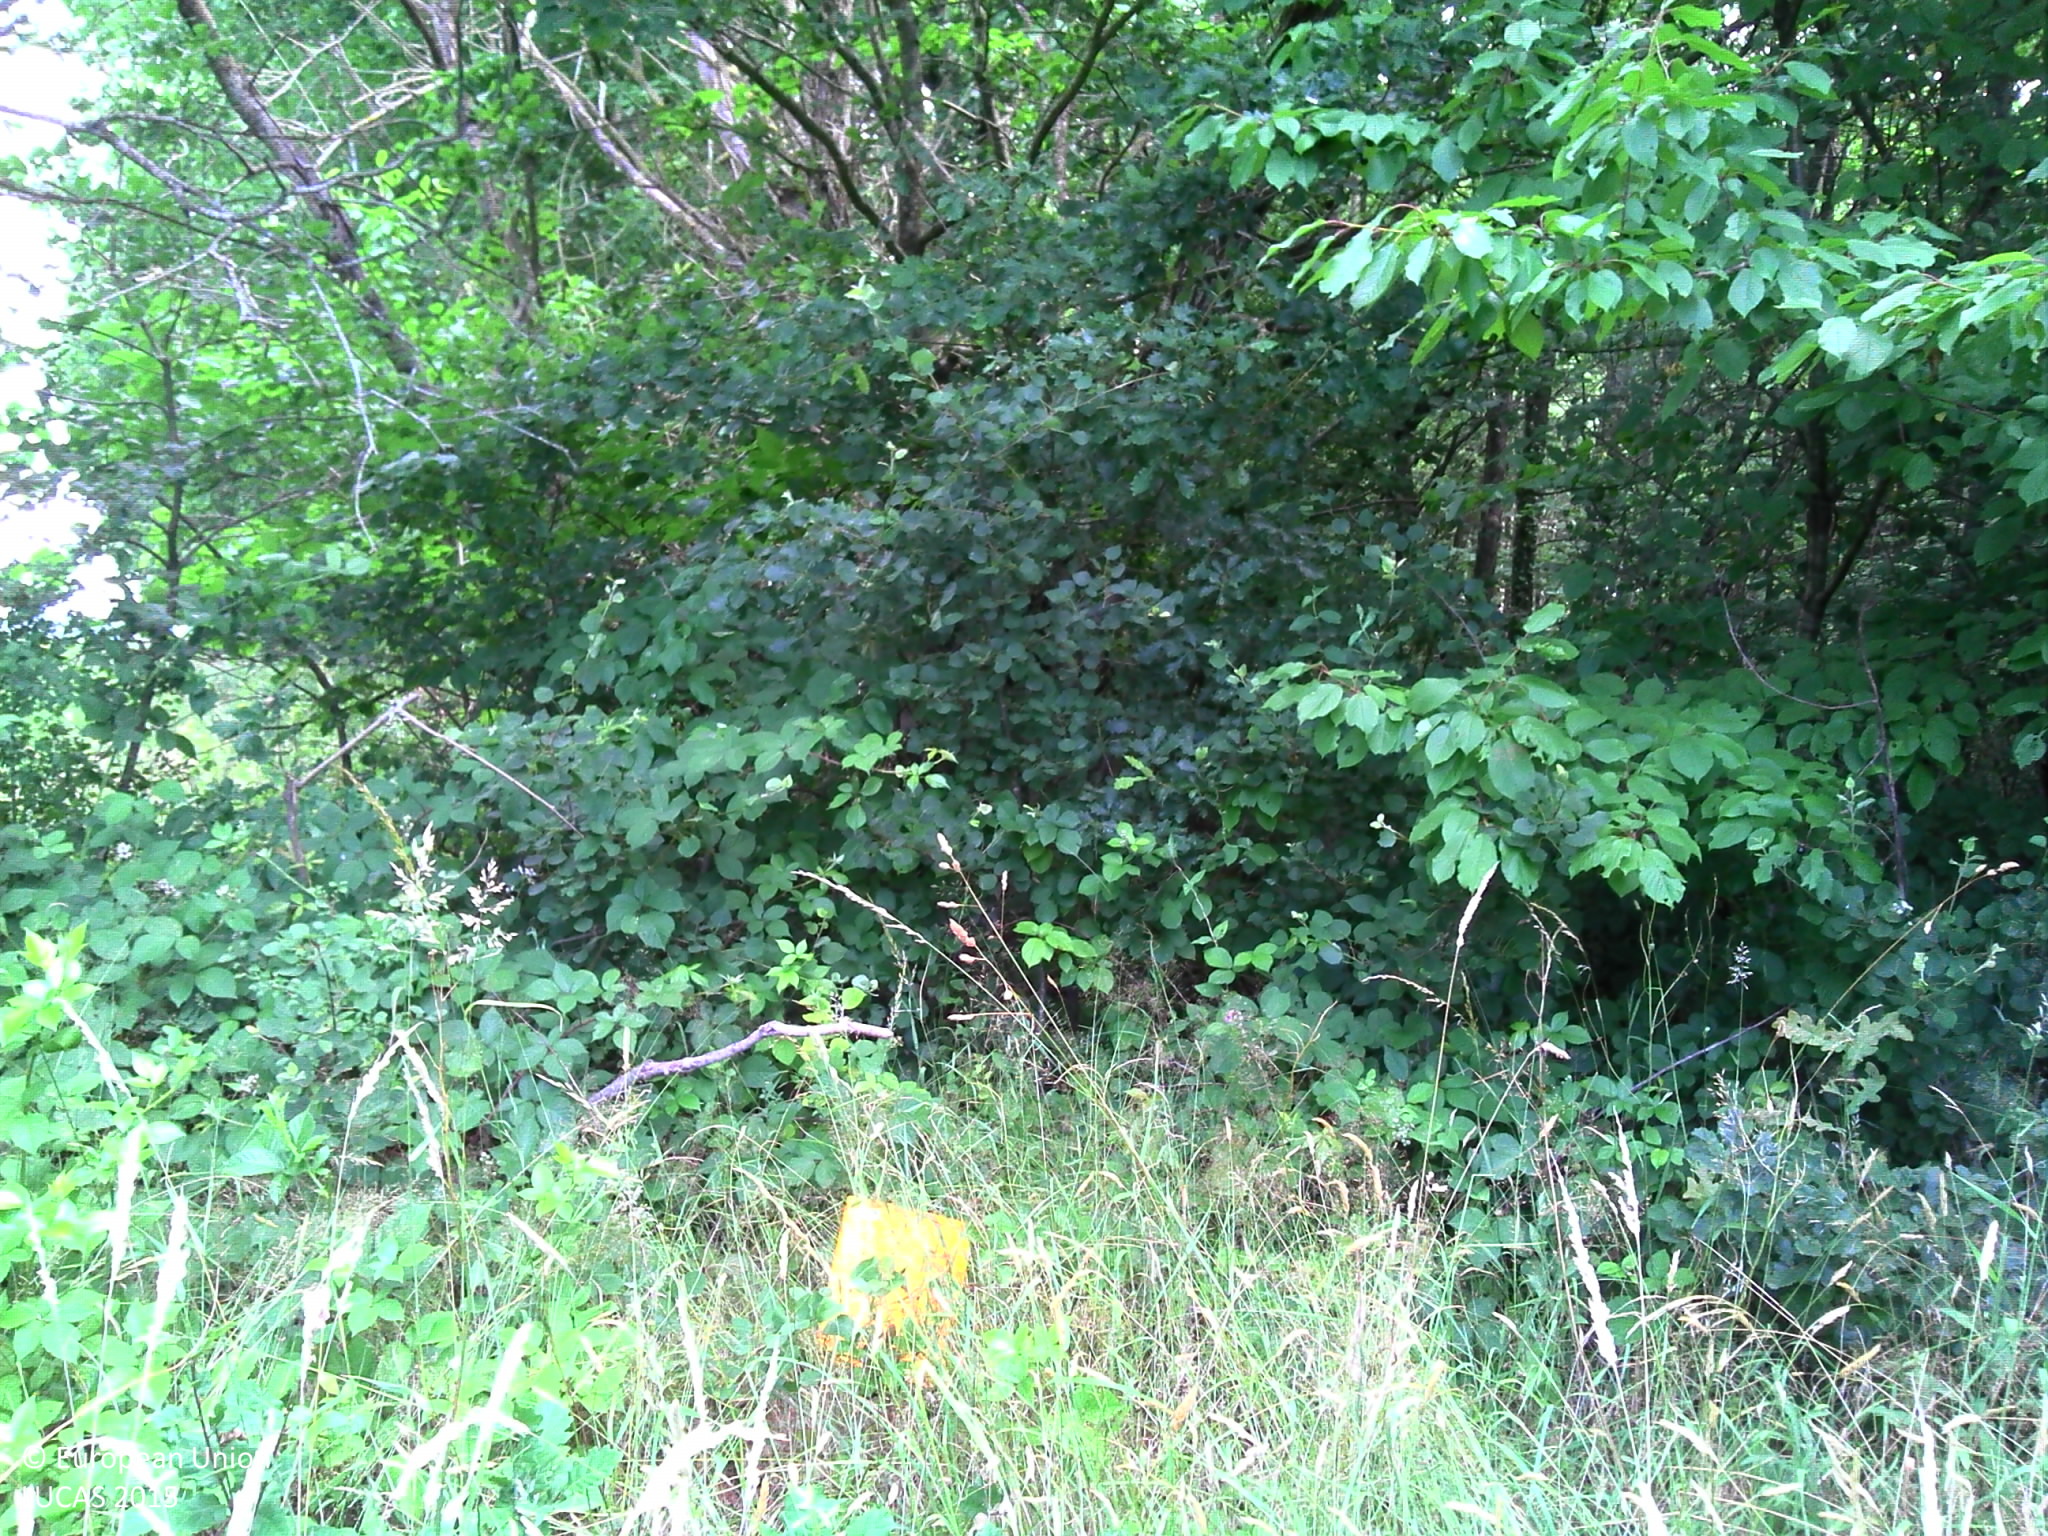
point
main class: Woodland
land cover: Broadleaved woodland
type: mesophytic deciduous forest
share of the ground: > 75 %
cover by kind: broadleaved forest trees 90 %, shrubs 5 %, herbaceous plants 5 %
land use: Forestry
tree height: > 5 m
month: June
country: FR
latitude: 46.3745
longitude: 3.2773
